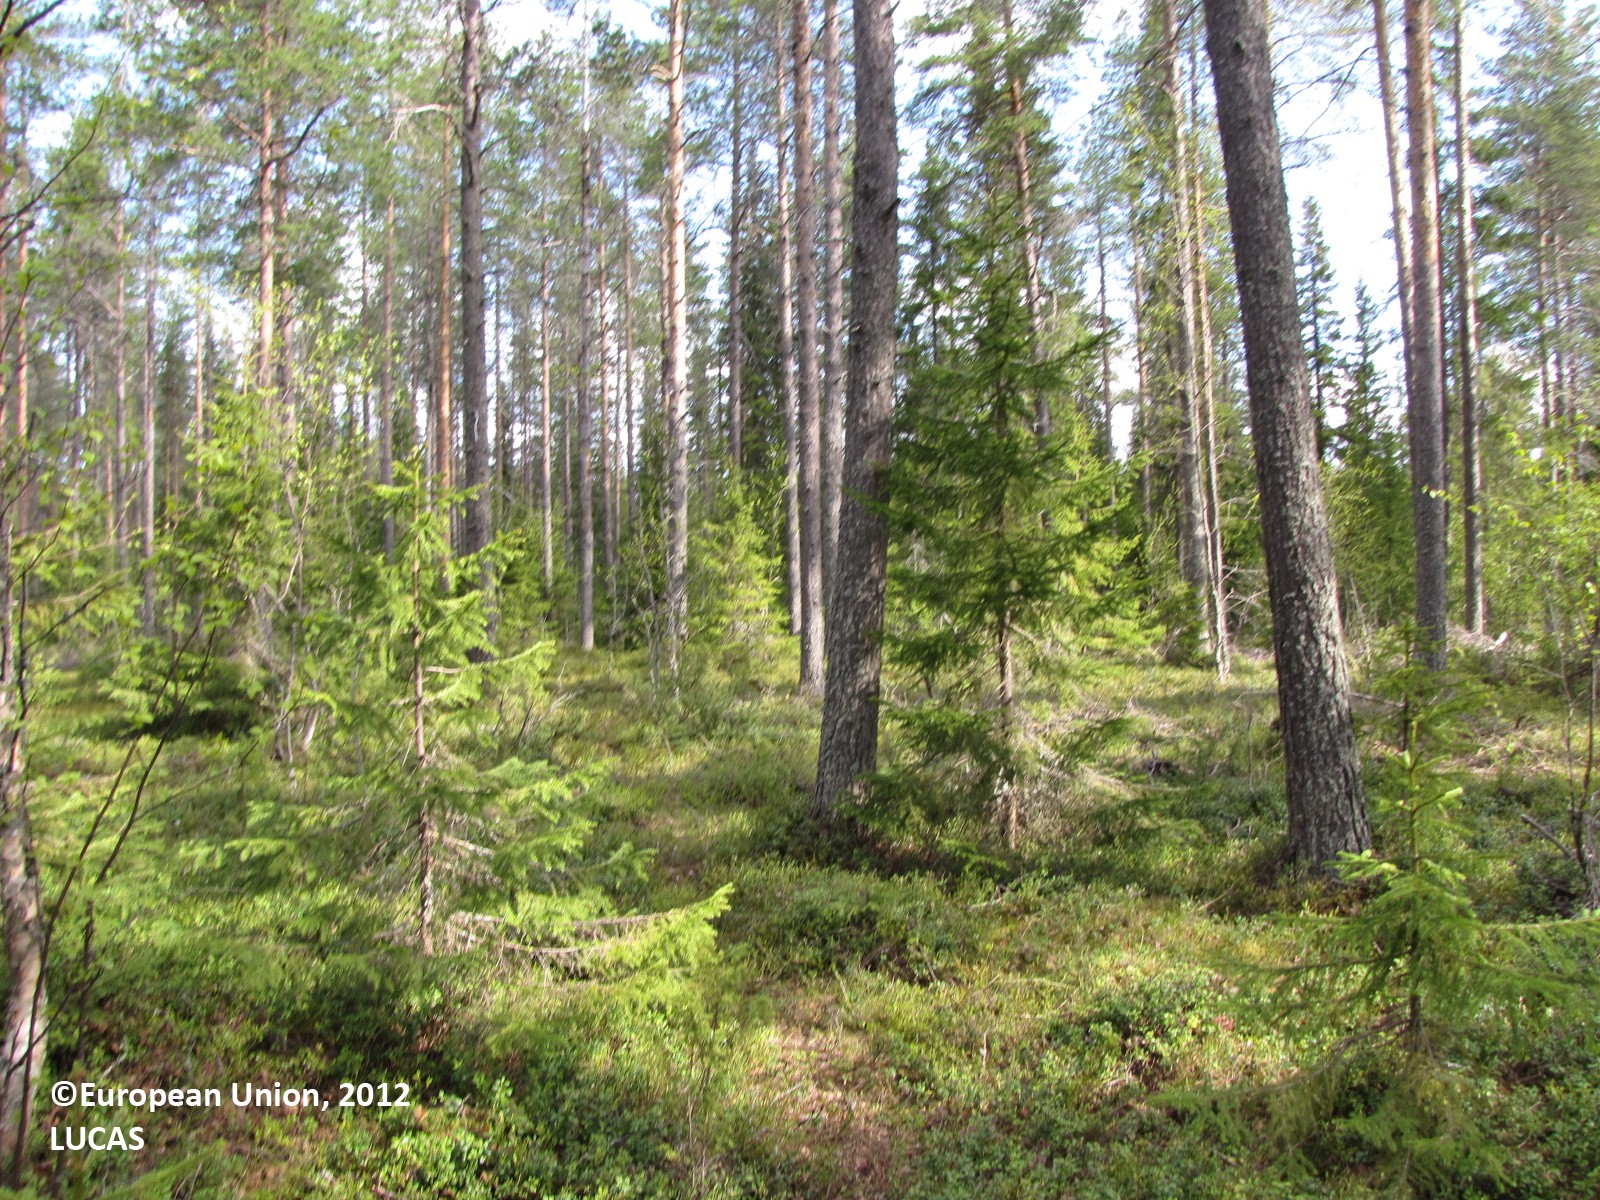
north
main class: Woodland
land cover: Pine dominated mixed woodland
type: boreal forest
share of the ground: > 75 %
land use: Forestry
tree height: > 5 m
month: June
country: FI
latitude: 65.7645
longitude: 24.6184
